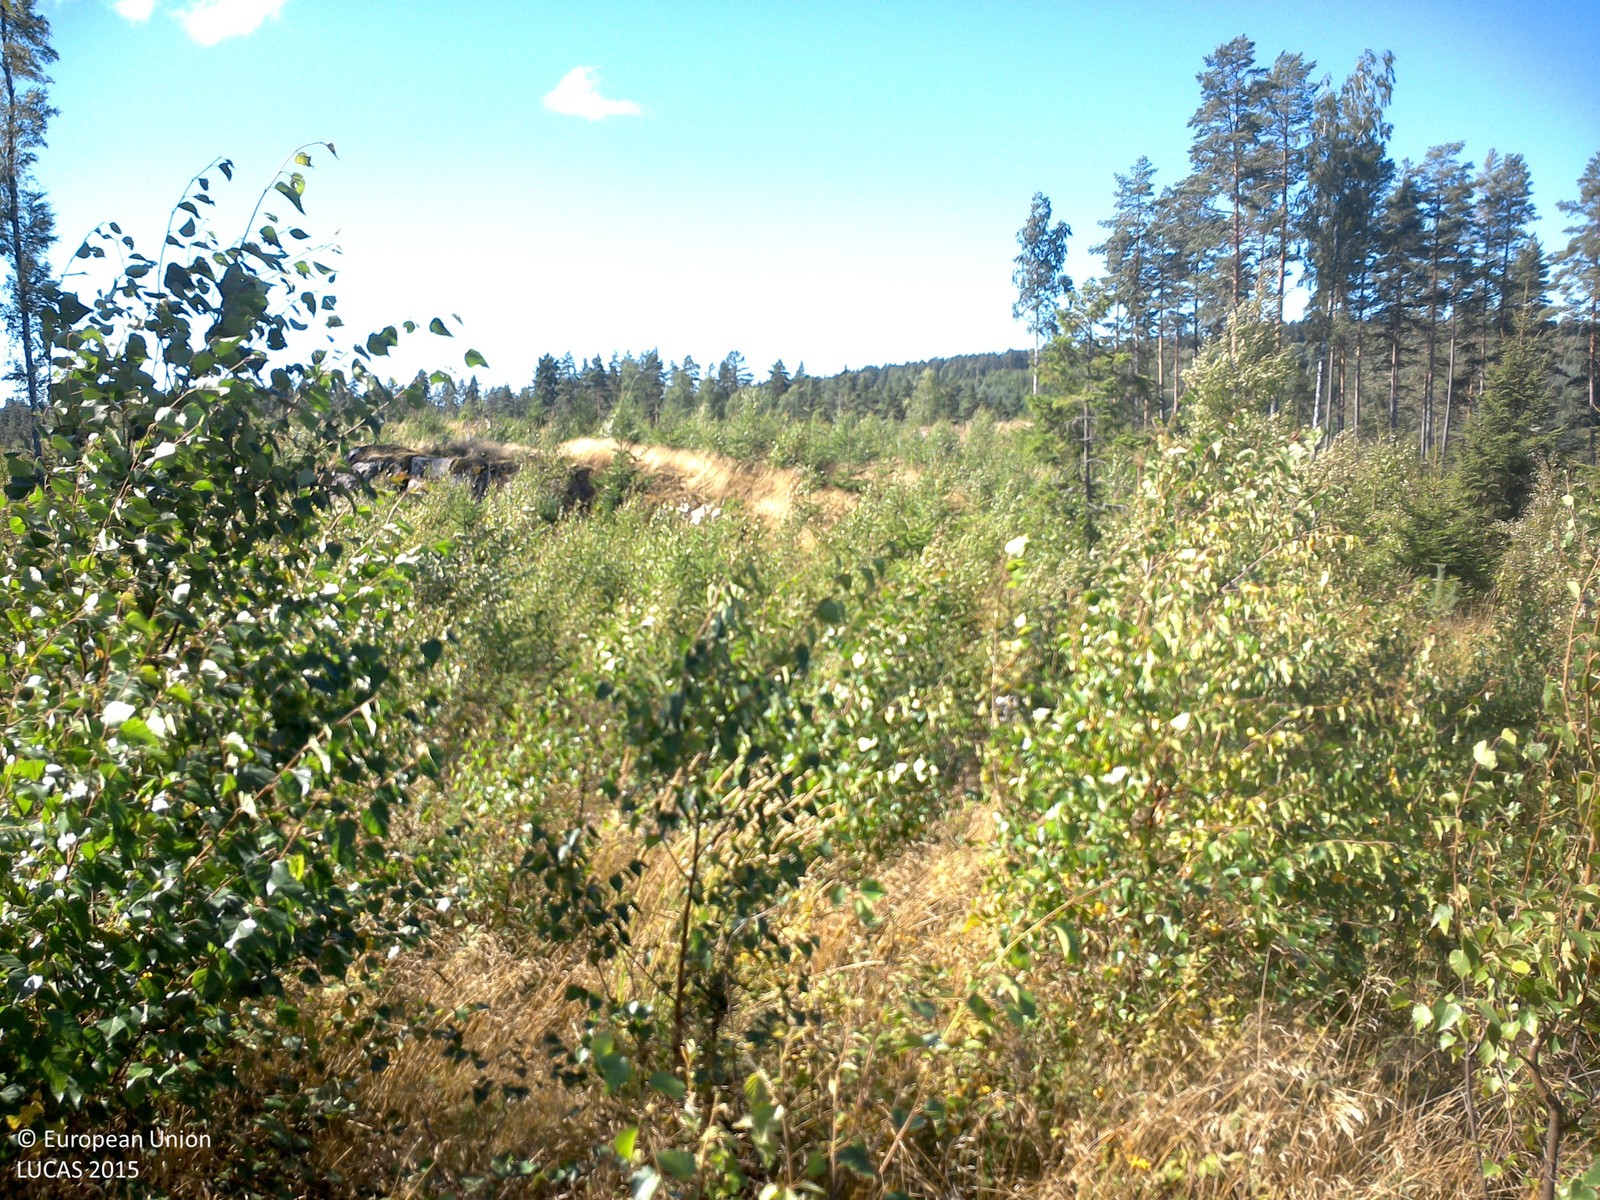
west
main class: Woodland
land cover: Broadleaved woodland
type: boreal forest
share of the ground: 25 - 50 %
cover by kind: herbaceous plants 50 %, broadleaved forest trees 45 %, shrubs 5 %
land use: Forestry
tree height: < 5 m
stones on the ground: < 10 %
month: August
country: SE
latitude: 57.8611
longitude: 15.3384
